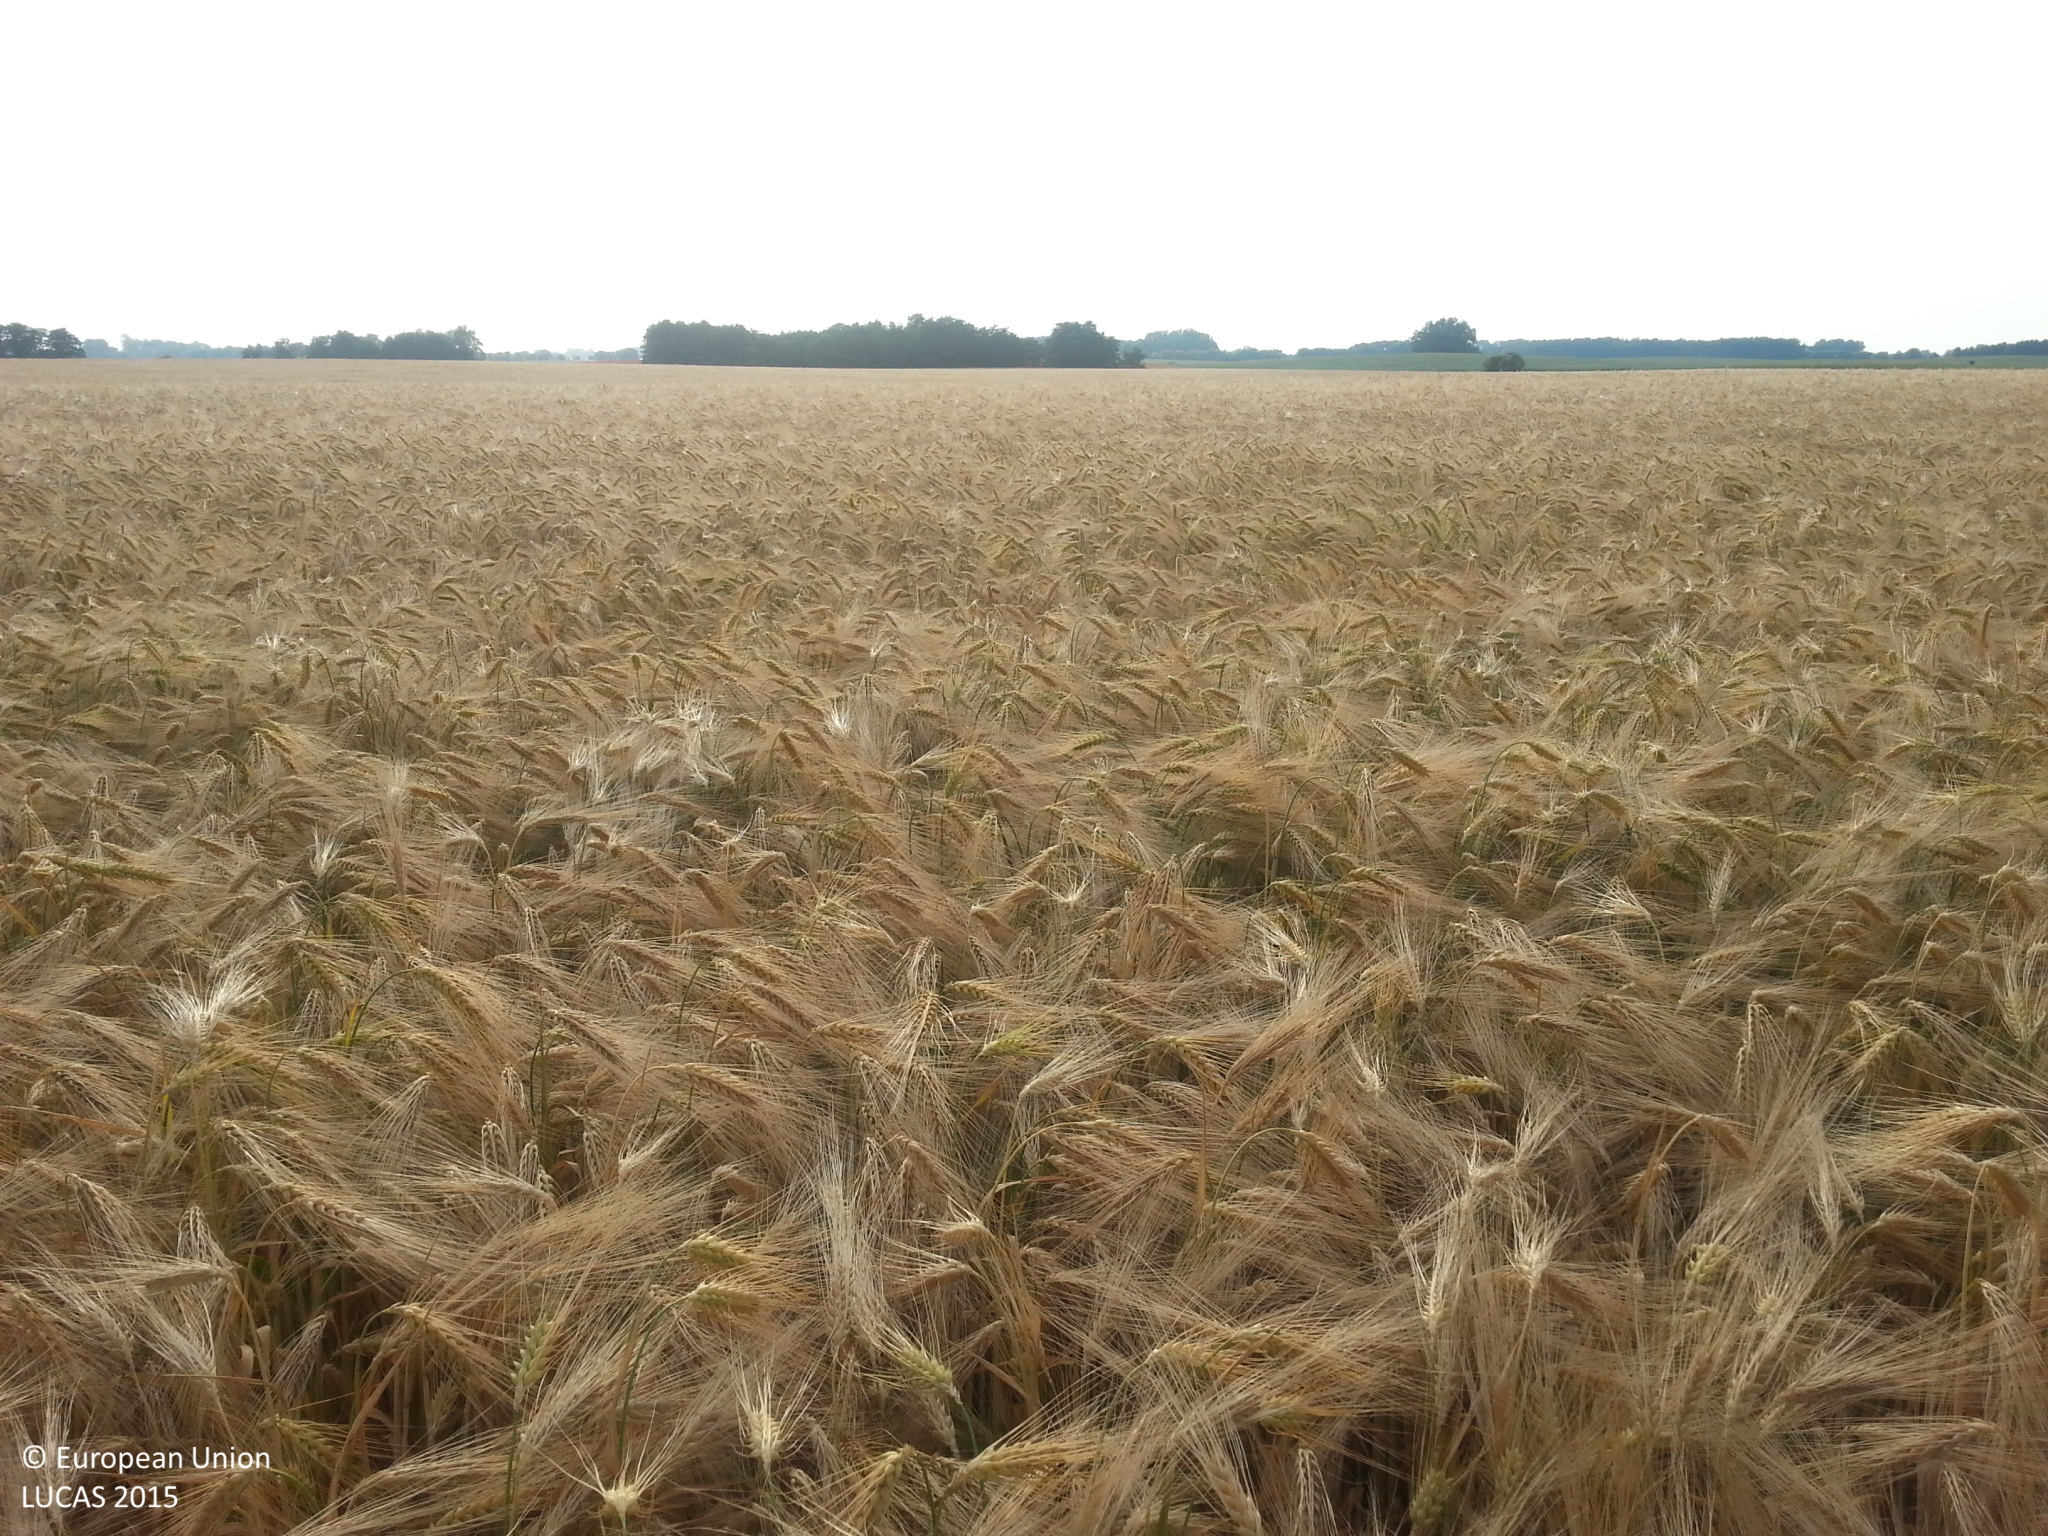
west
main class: Cropland
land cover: Barley
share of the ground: > 75 %
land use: Agriculture (excluding fallow land and kitchen gardens)
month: July
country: DE
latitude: 53.9846
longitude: 11.6005
